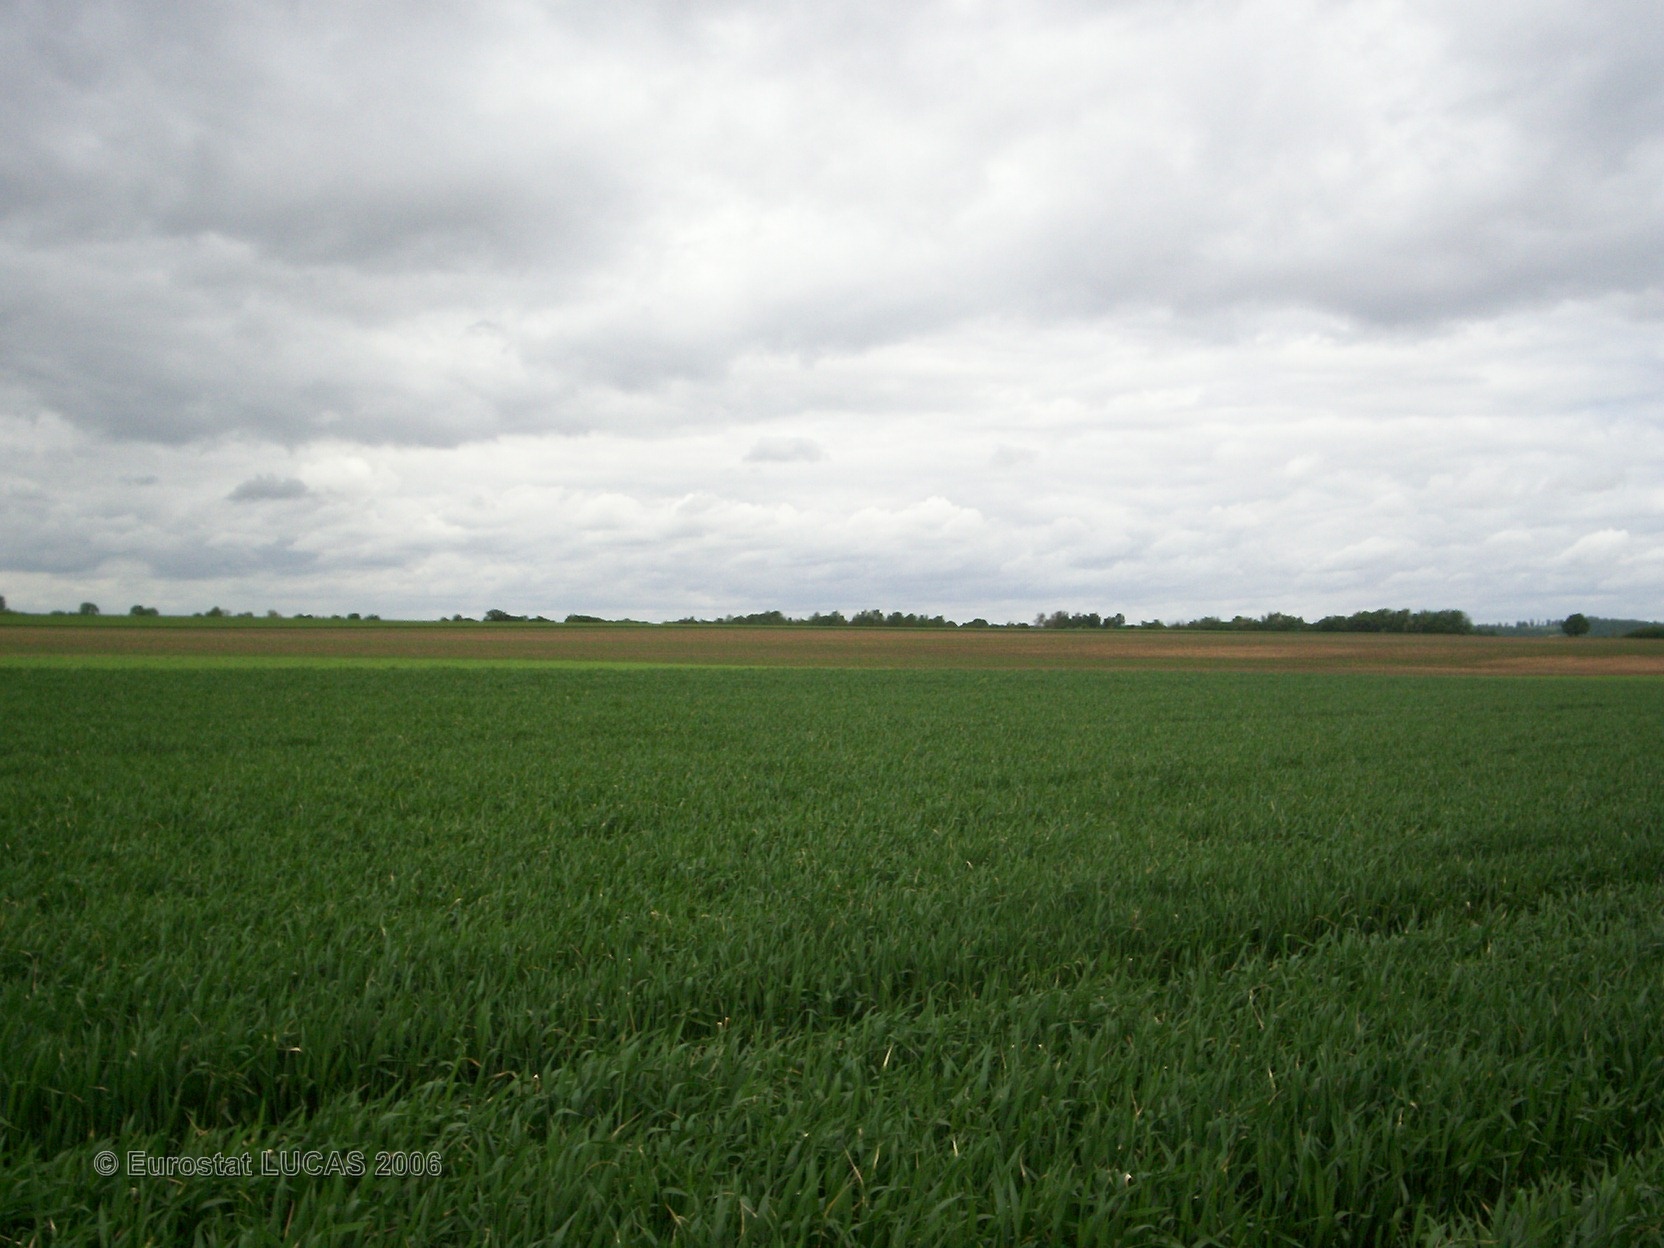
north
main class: Cropland
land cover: Common wheat
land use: Agriculture (excluding fallow land and kitchen gardens)
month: May
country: FR
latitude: 49.1417
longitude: 2.7657
